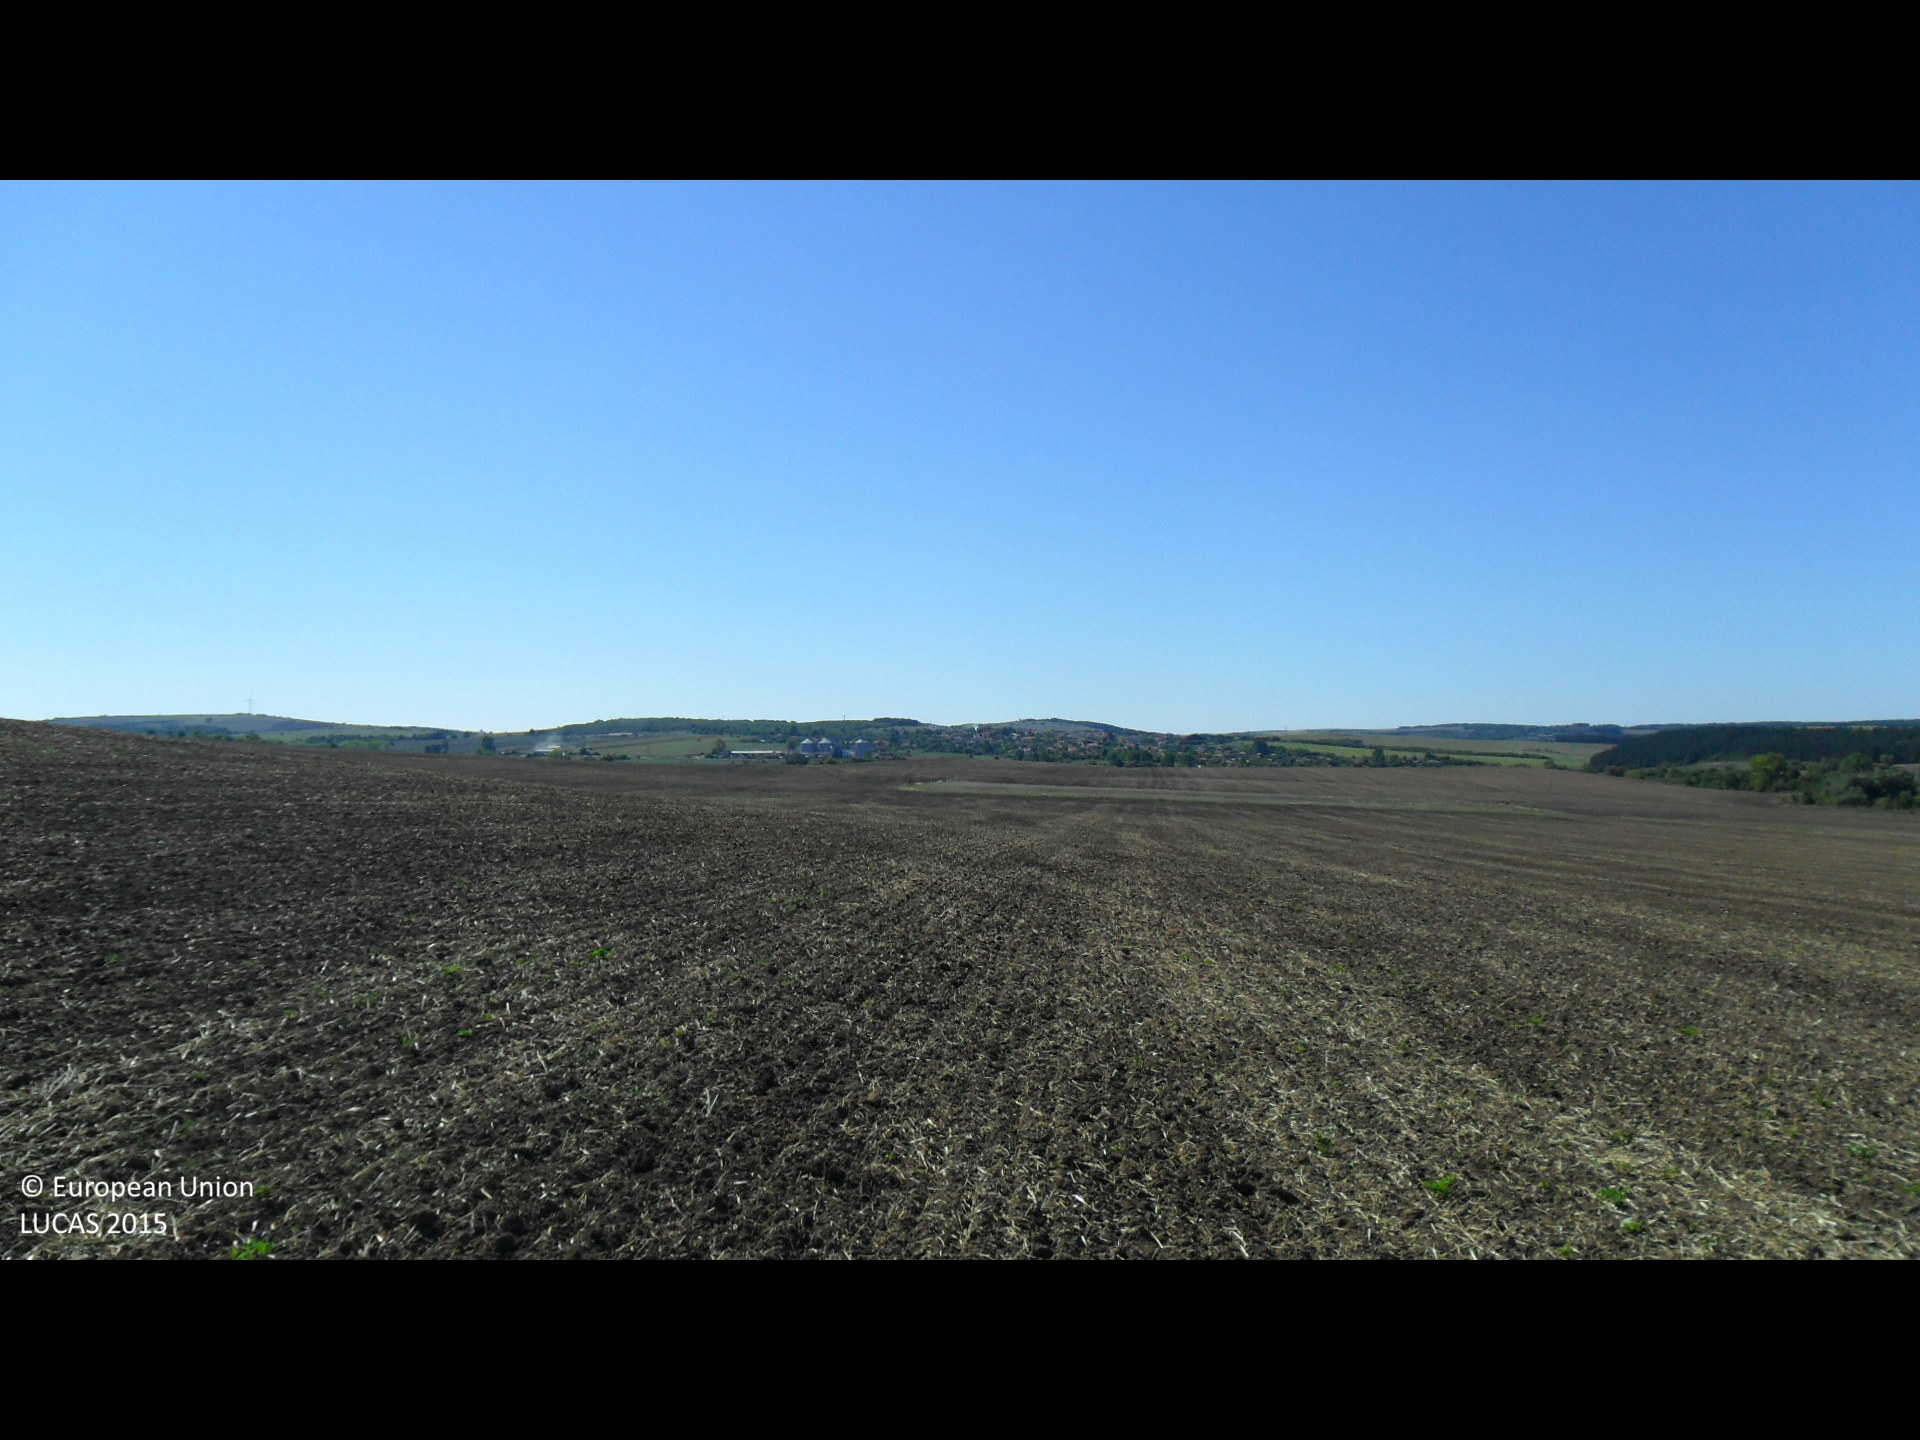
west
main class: Cropland
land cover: Common wheat
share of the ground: < 10 %
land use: Agriculture (excluding fallow land and kitchen gardens)
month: September
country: BG
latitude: 43.1351
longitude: 26.4623
